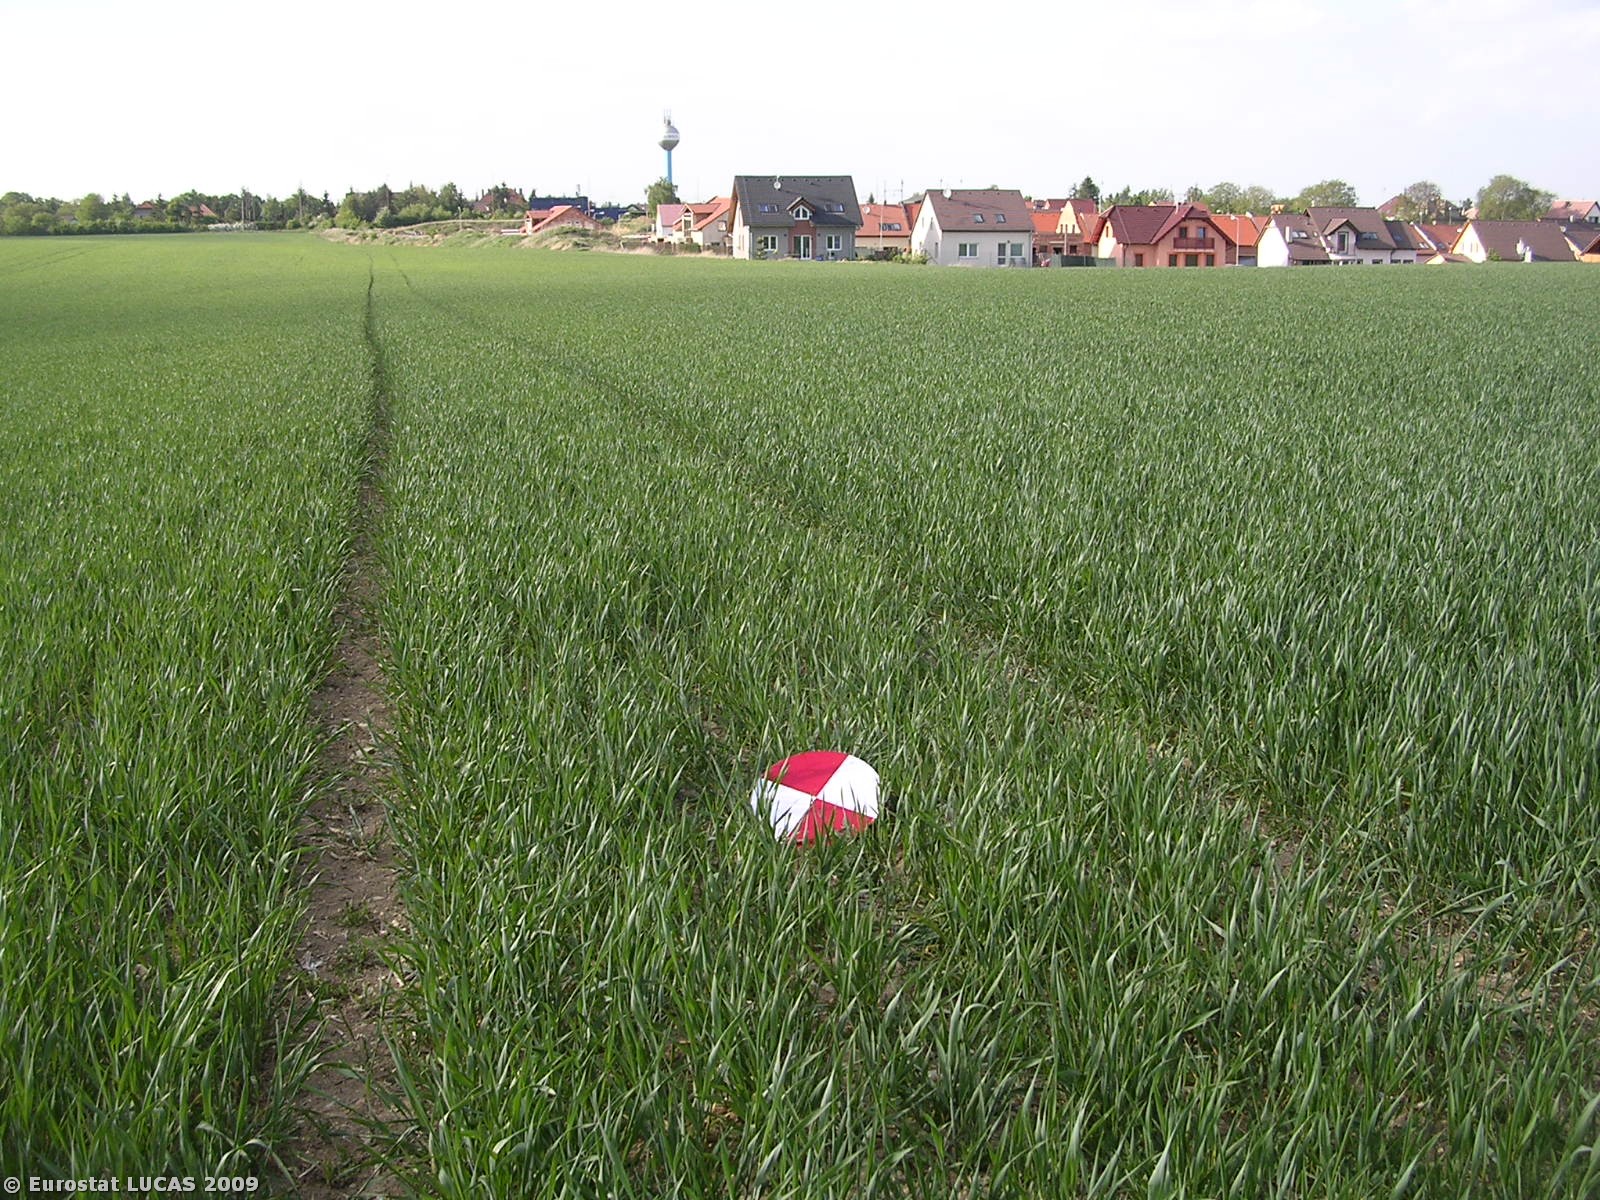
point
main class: Cropland
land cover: Common wheat
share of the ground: > 75 %
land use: Agriculture (excluding fallow land and kitchen gardens)
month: May
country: CZ
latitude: 50.1251
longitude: 14.6599
